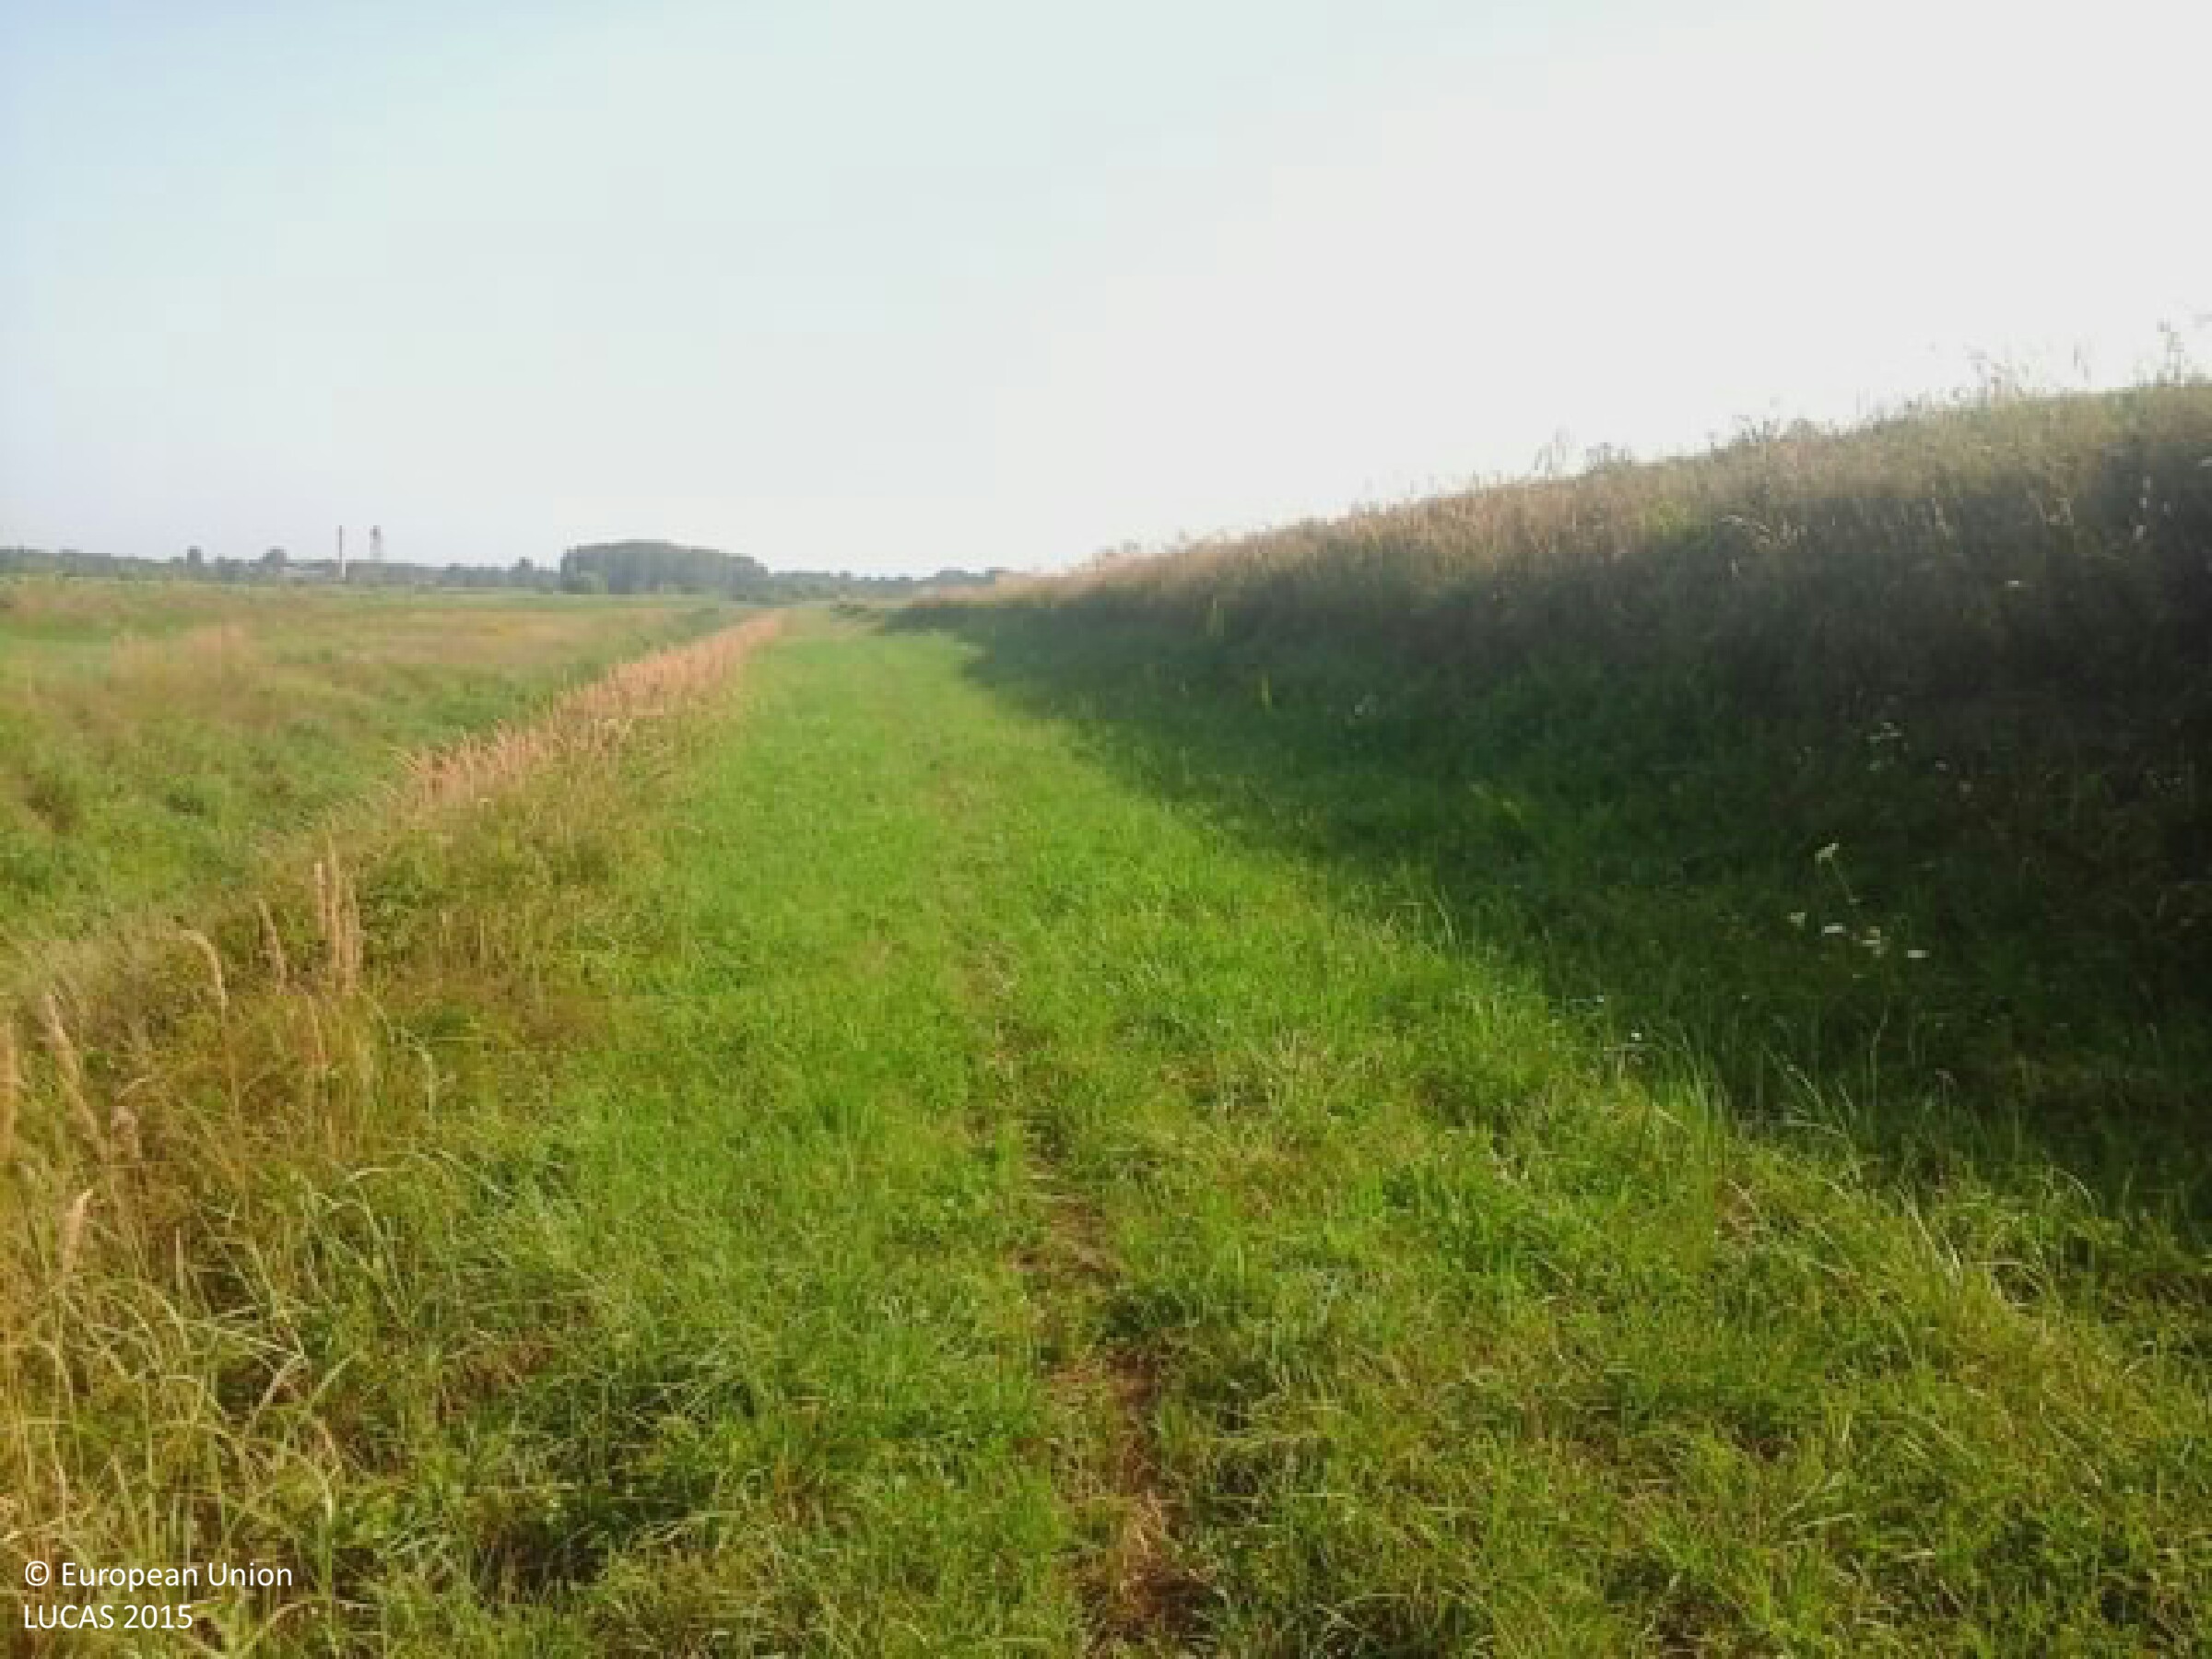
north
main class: Grassland
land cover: Grassland without tree/shrub cover
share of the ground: > 75 %
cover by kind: herbaceous plants 100 %
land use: Protection infrastructures
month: August
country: HU
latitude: 46.3650
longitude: 18.1576
